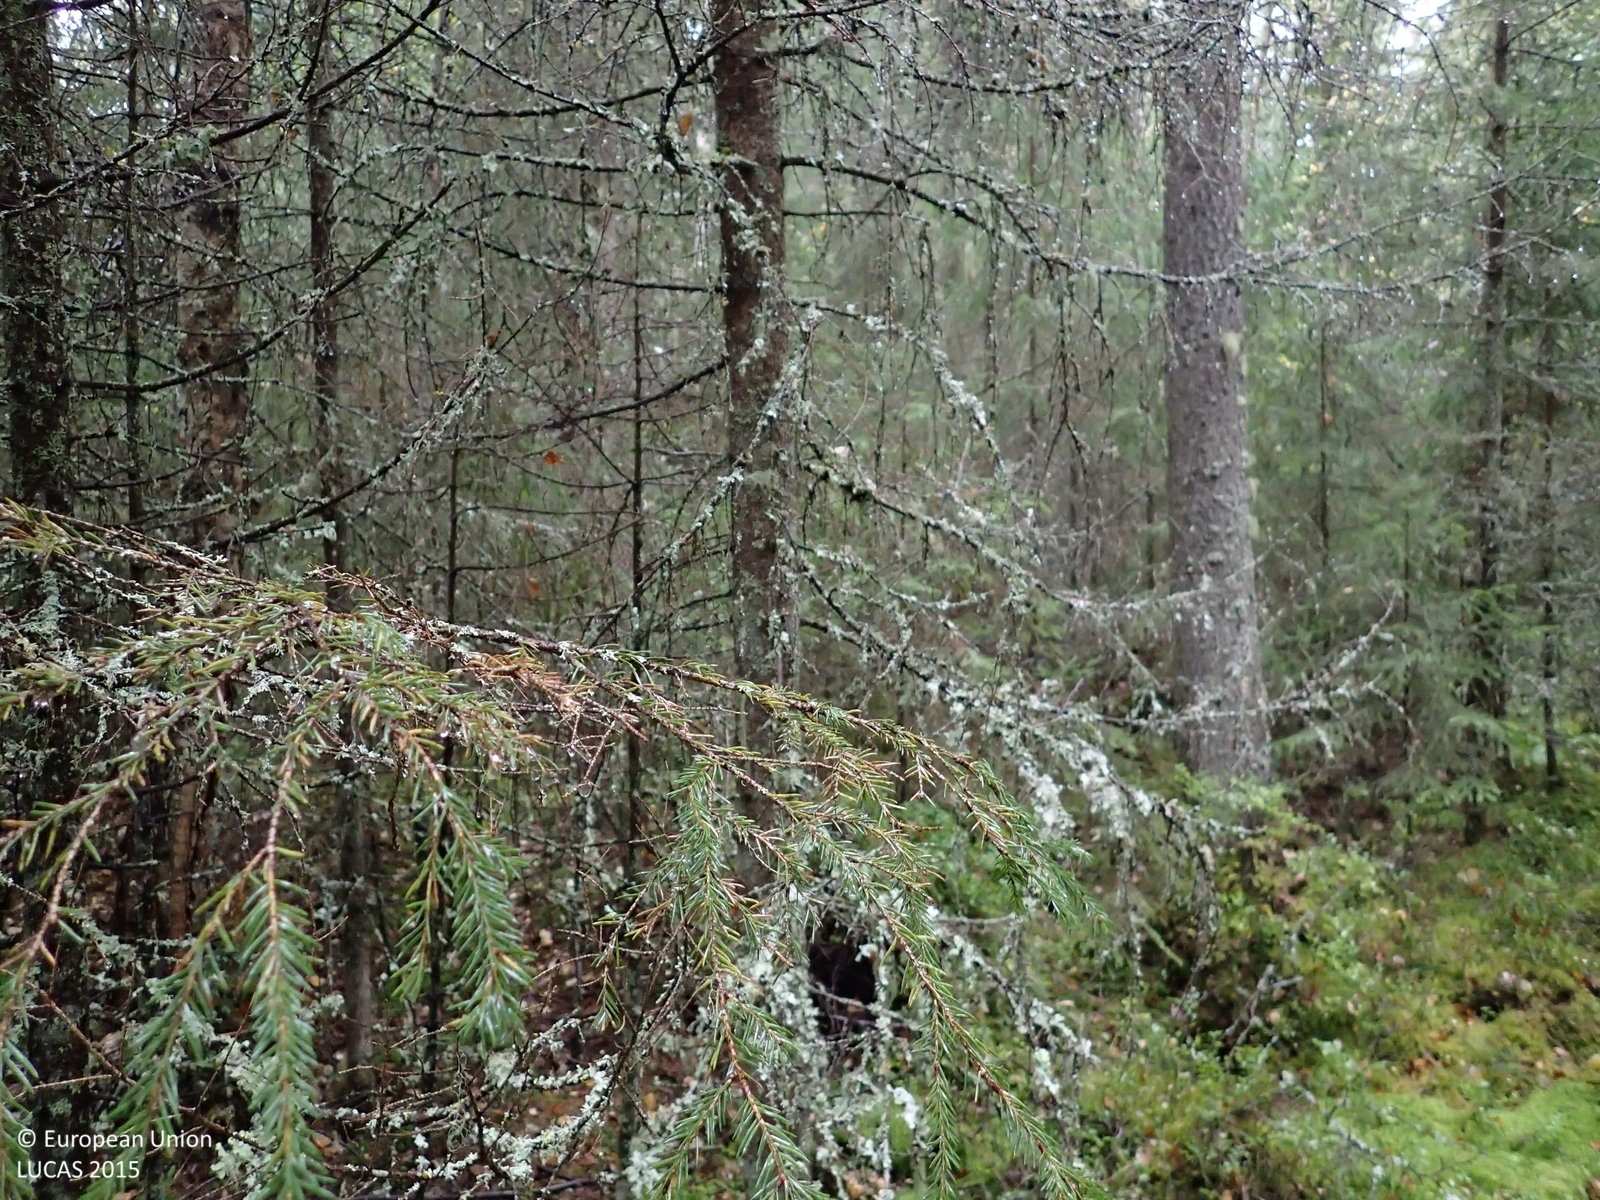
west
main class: Woodland
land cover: Spruce dominated coniferous woodland
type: boreal forest
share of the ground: > 75 %
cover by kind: coniferous forest trees 70 %, broadleaved forest trees 10 %, shrubs 10 %, lichens and mosses 10 %
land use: Forestry
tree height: > 5 m
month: September
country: FI
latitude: 63.1523
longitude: 26.1782
